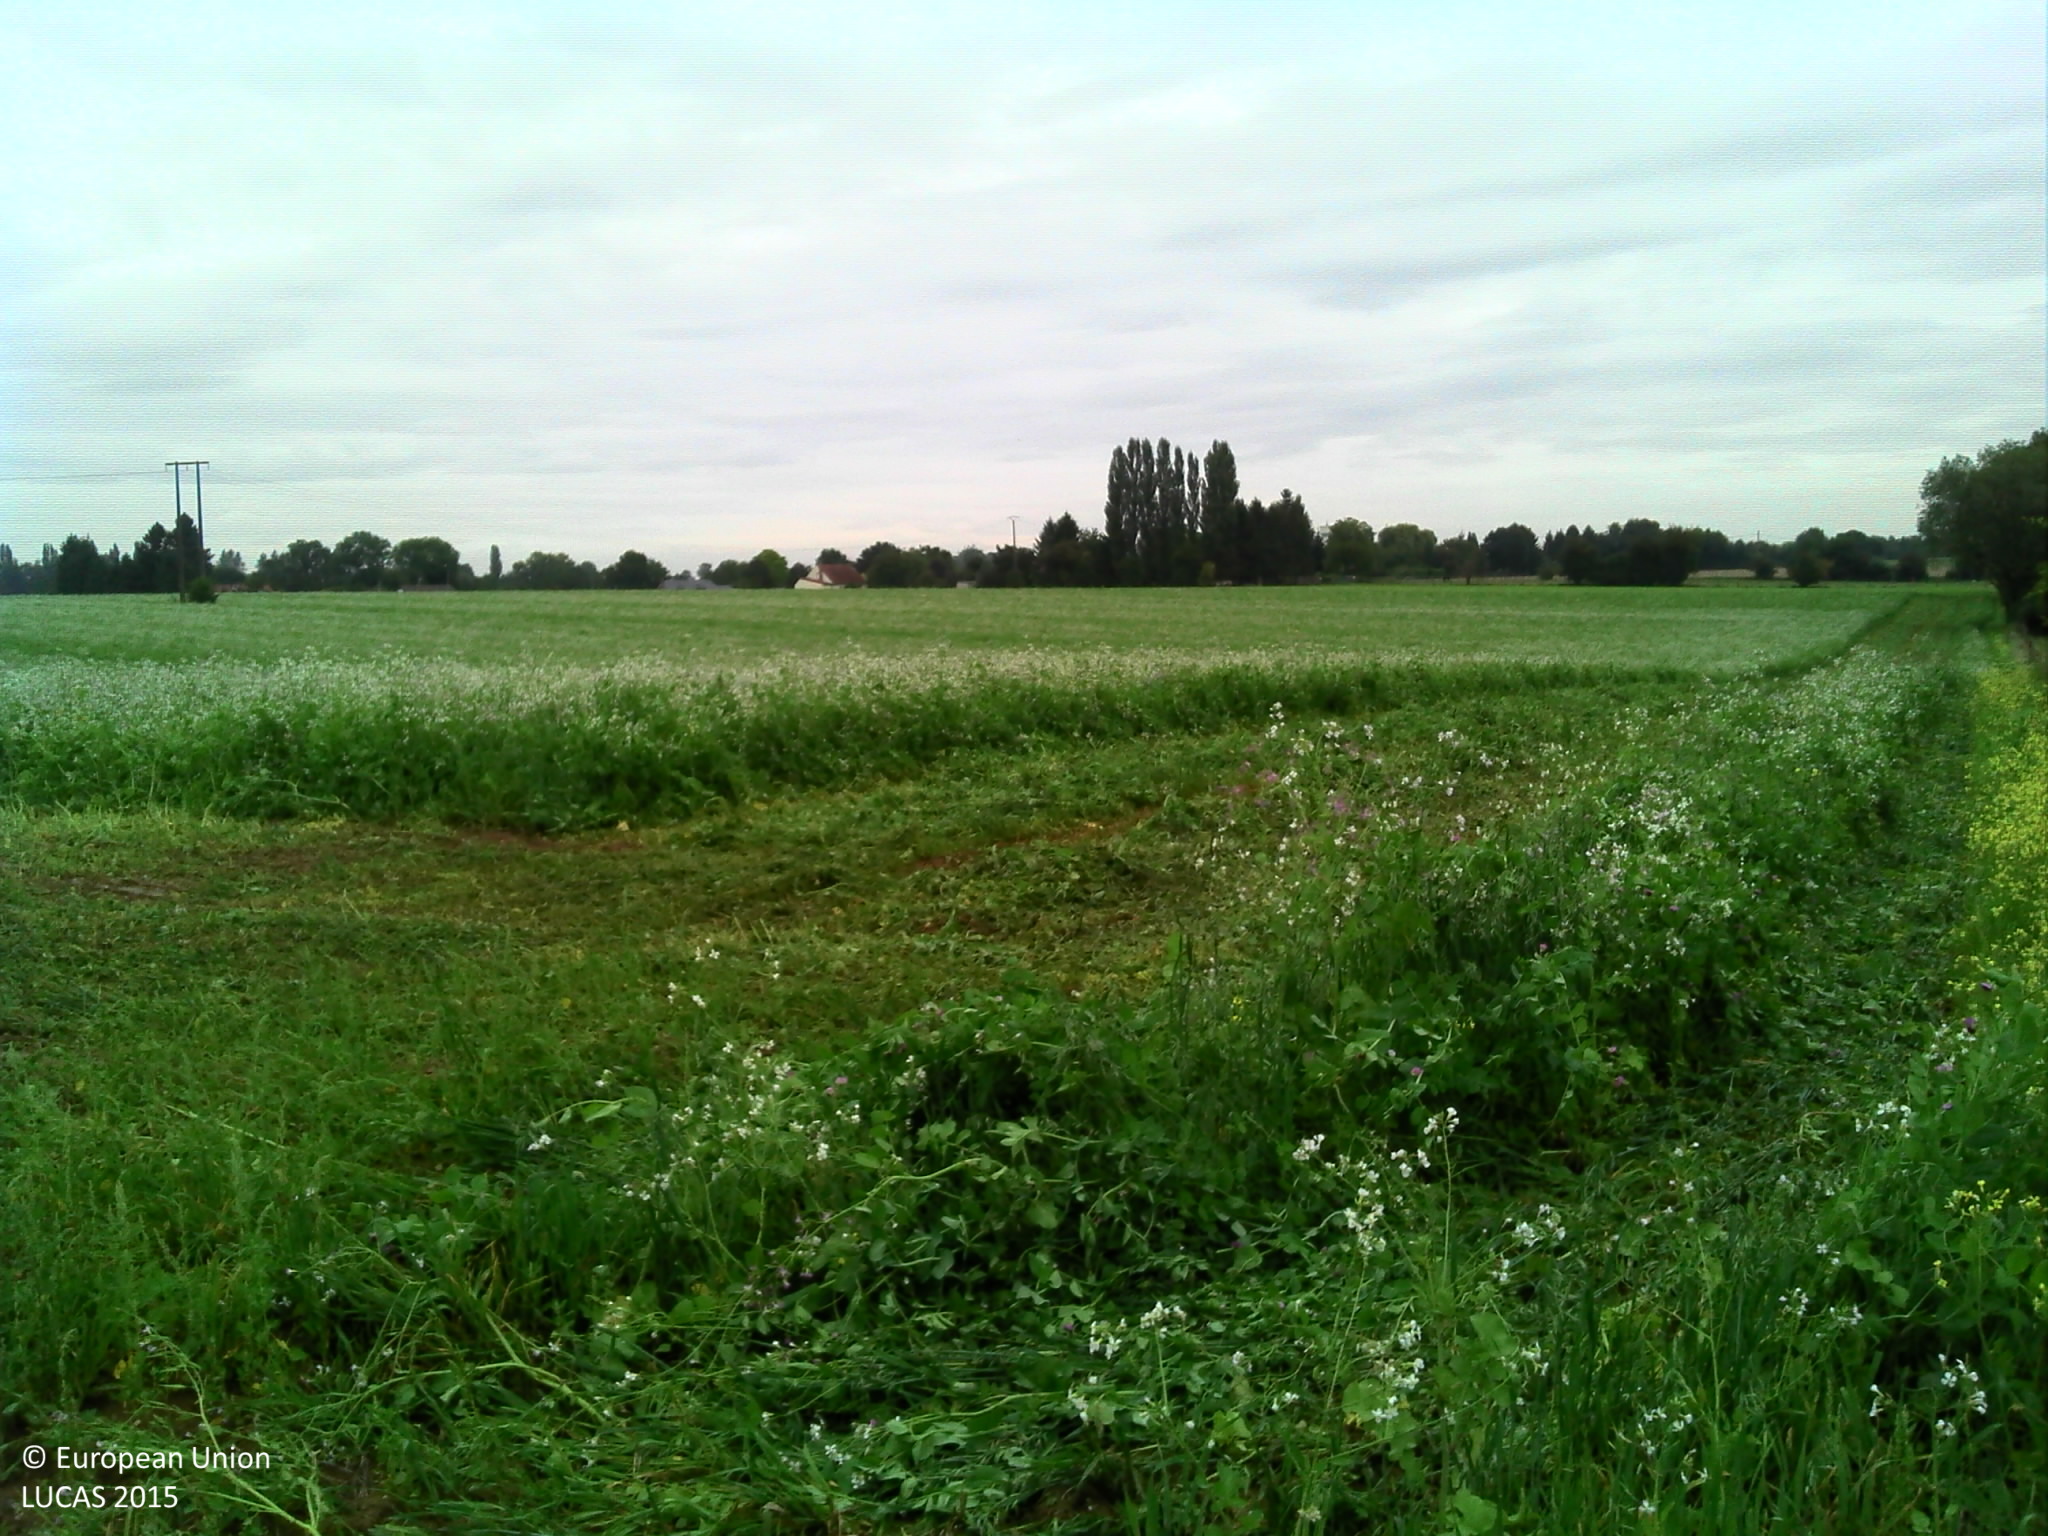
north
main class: Grassland
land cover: Grassland without tree/shrub cover
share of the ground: > 75 %
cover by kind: herbaceous plants 95 %, lichens and mosses 5 %
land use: Agriculture (excluding fallow land and kitchen gardens)
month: September
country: FR
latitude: 50.3147
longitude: 3.9978
